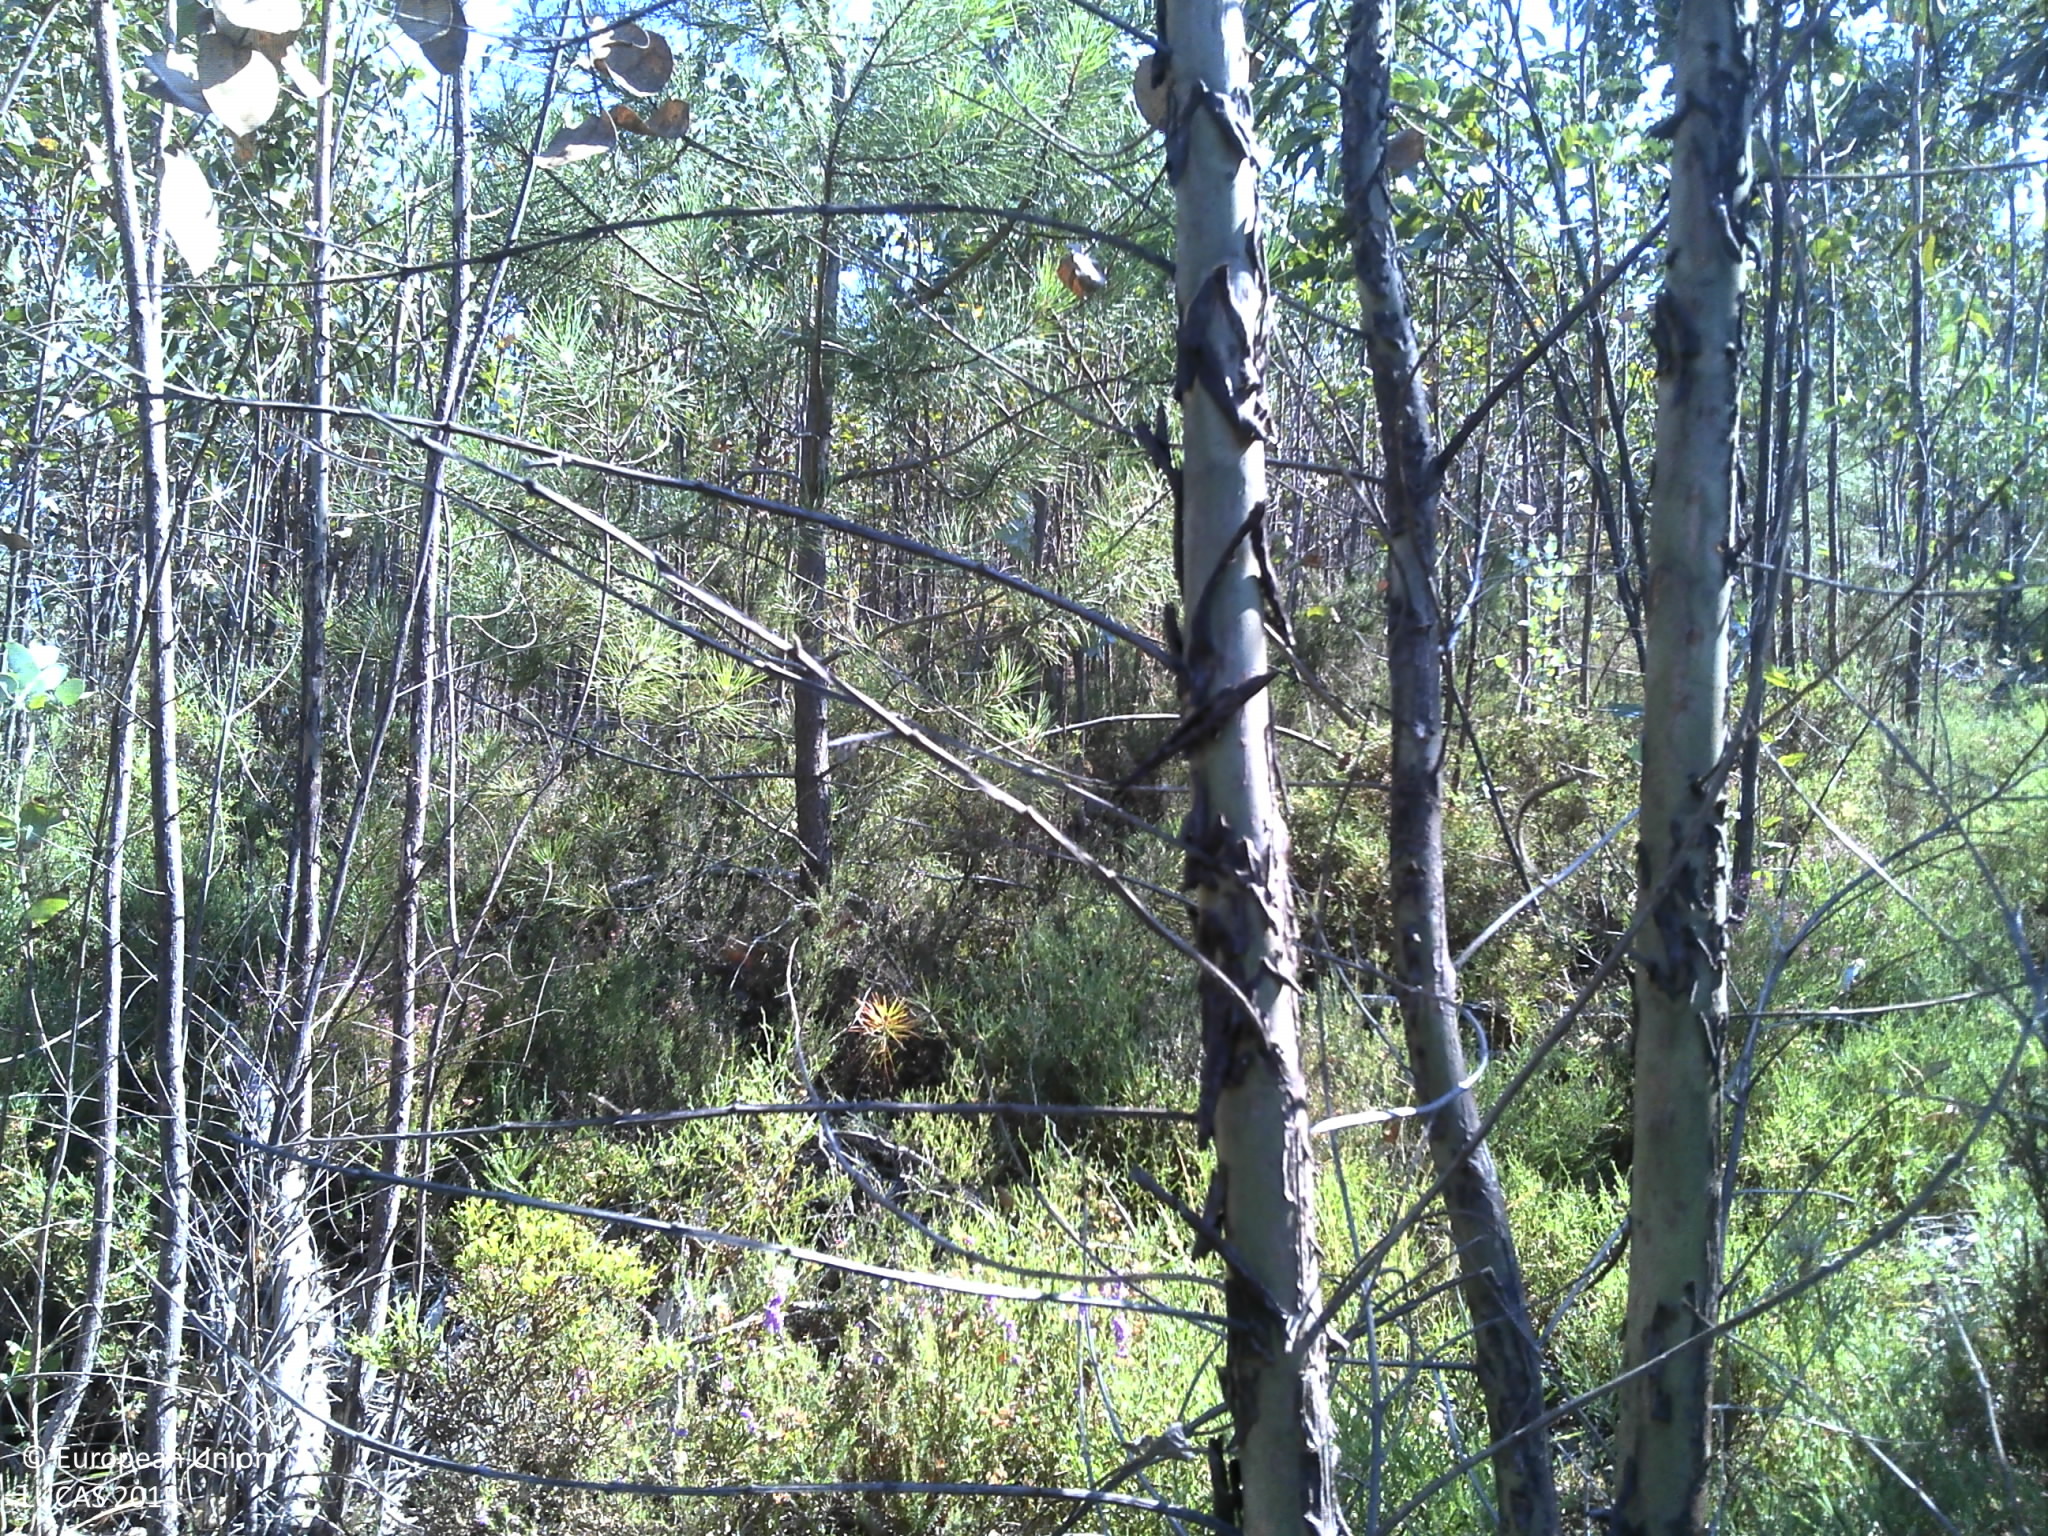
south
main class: Woodland
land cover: Broadleaved woodland
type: exotic forest
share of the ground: 10 - 25 %
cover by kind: shrubs 70 %, broadleaved forest trees 20 %, unconsolidated bare surface 10 %
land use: Forestry
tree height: < 5 m
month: June
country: PT
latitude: 40.0708
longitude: -8.0698
